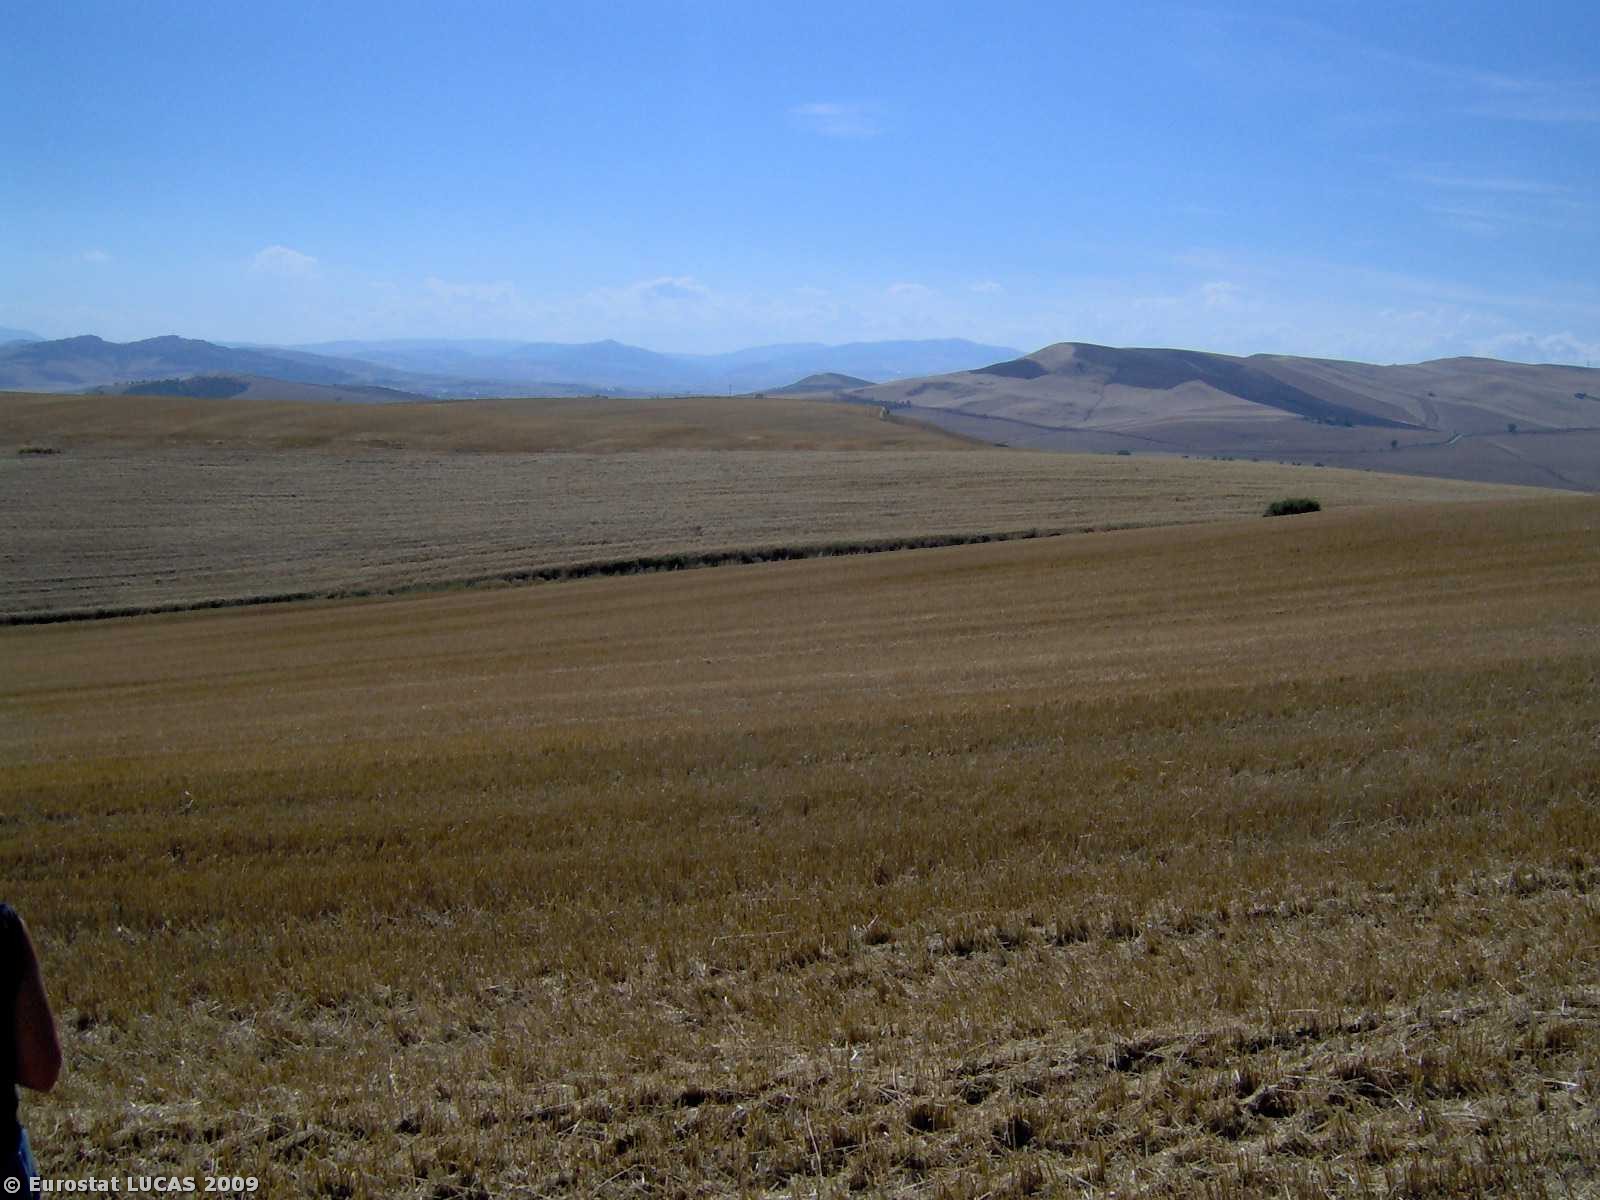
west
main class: Cropland
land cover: Durum wheat
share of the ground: < 10 %
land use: Agriculture (excluding fallow land and kitchen gardens)
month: July
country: IT
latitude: 41.1579
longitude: 15.6172
